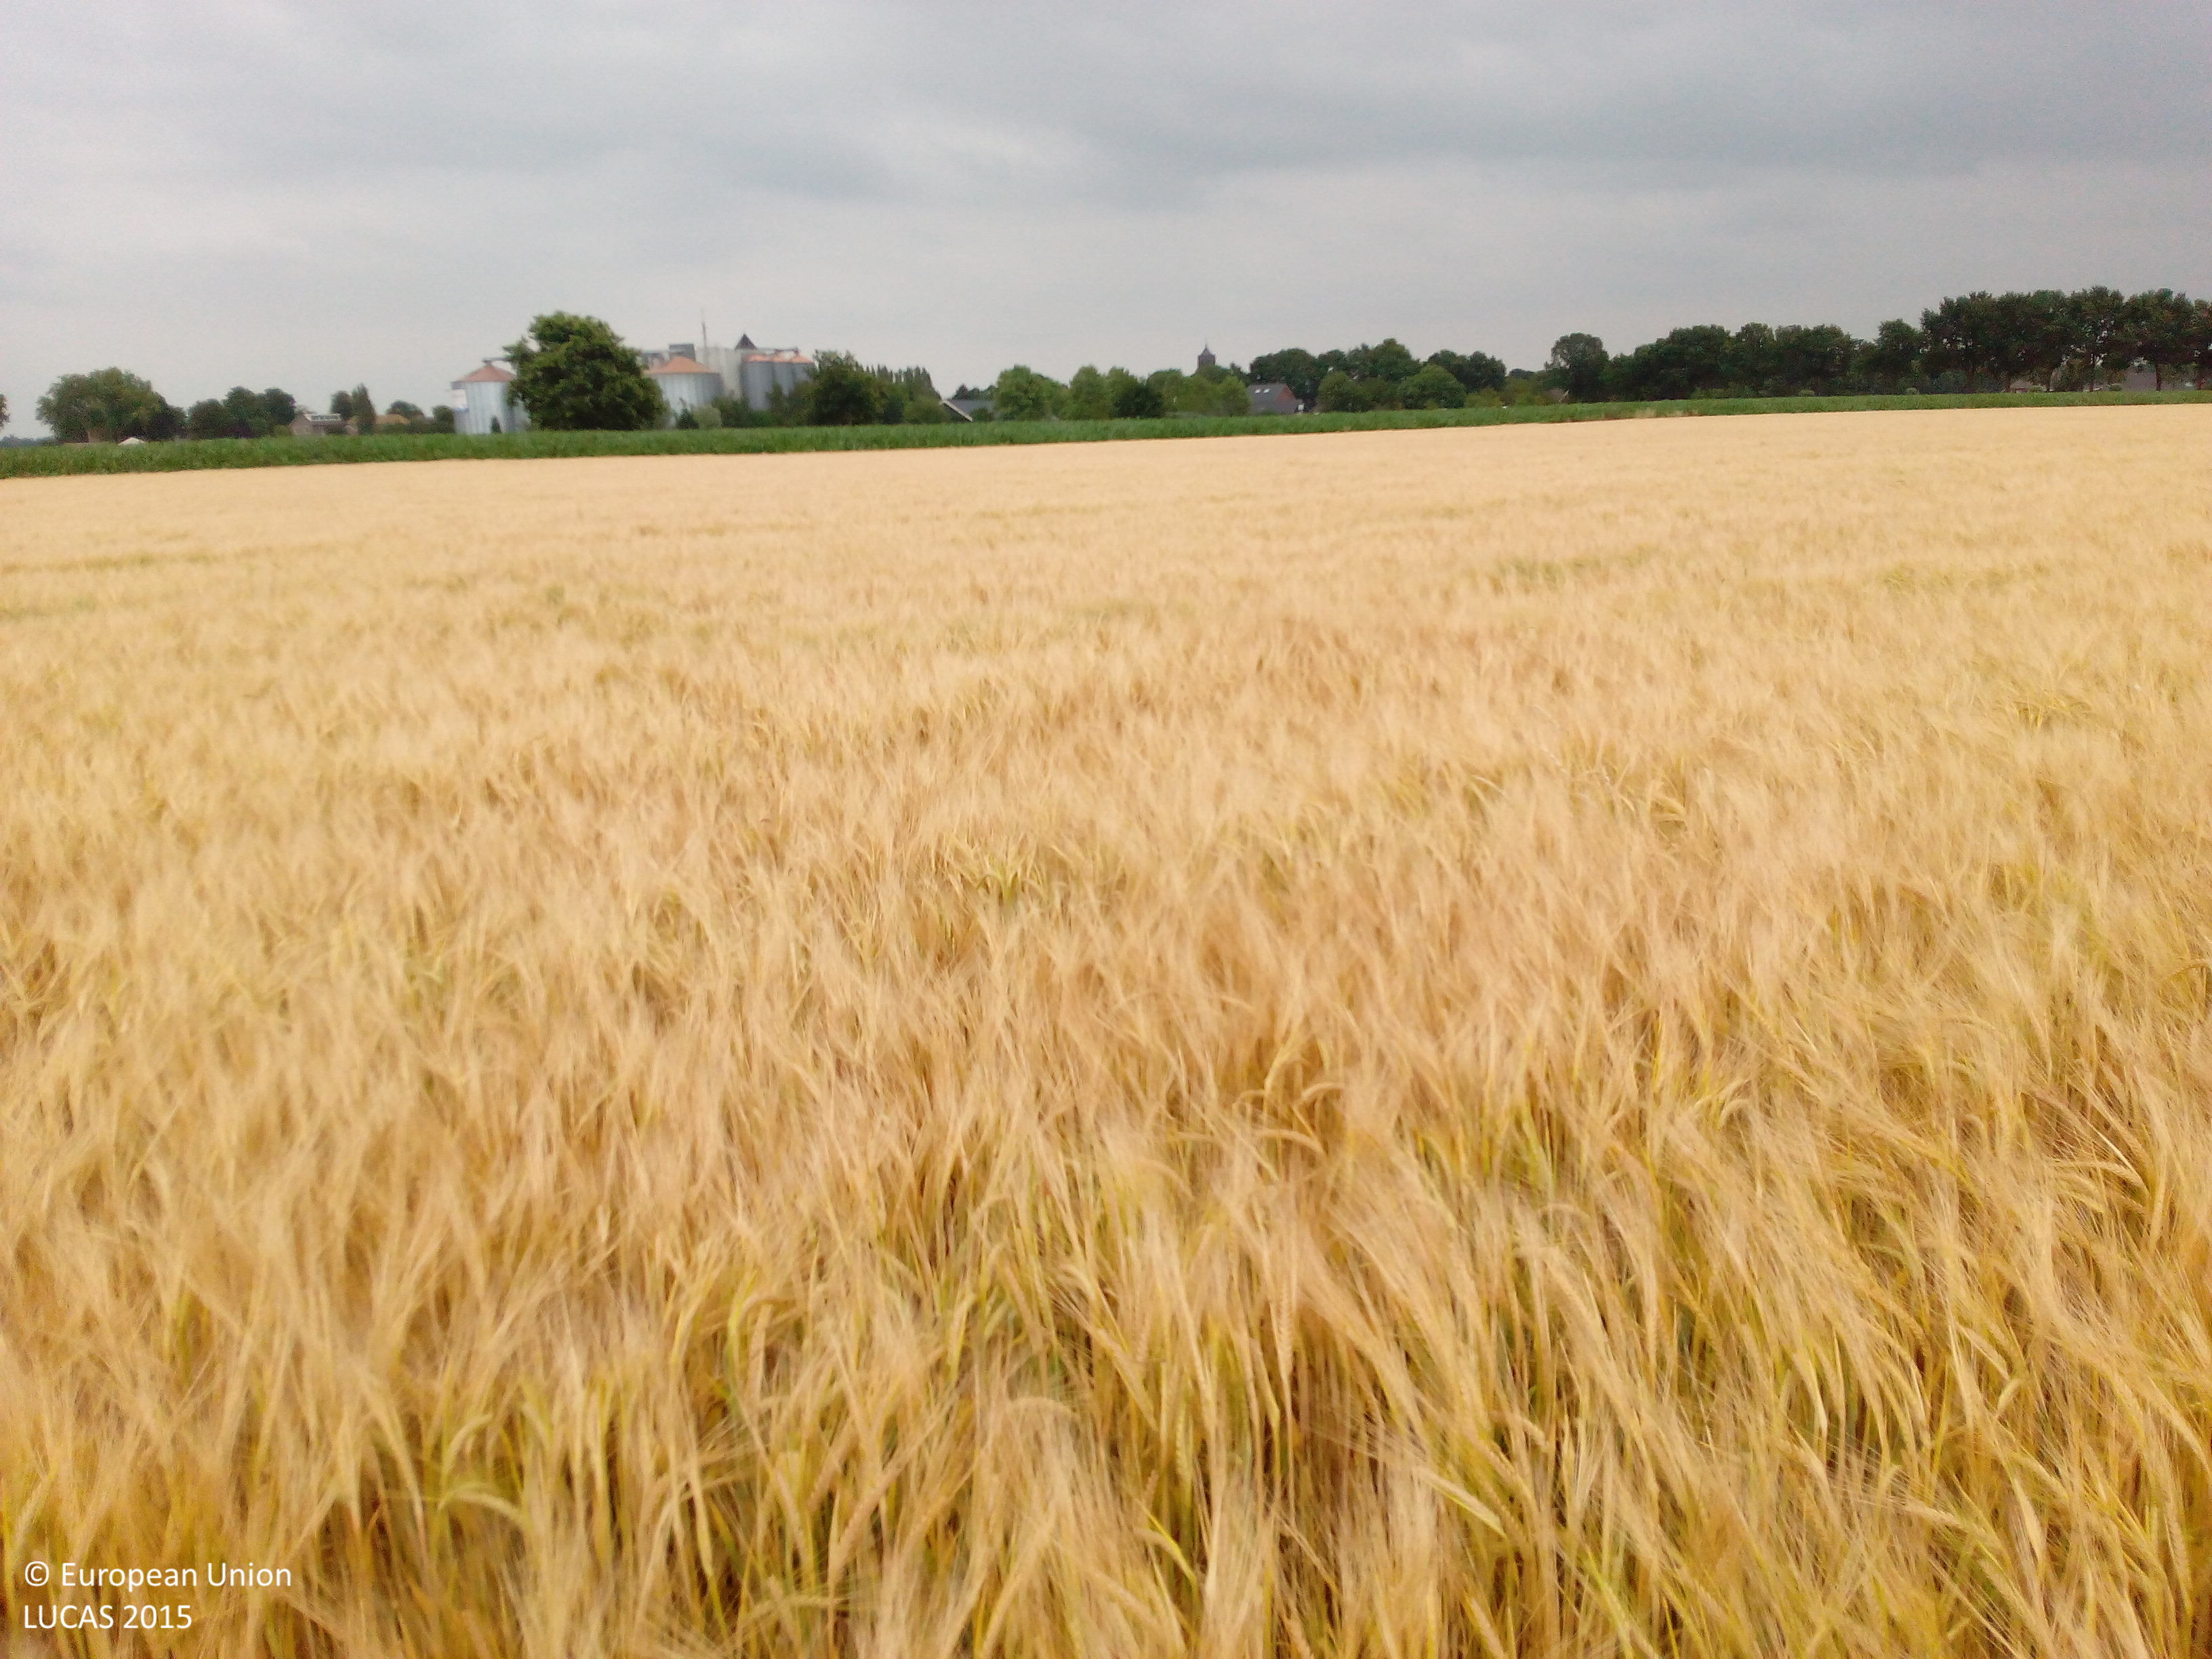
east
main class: Cropland
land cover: Barley
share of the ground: > 75 %
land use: Agriculture (excluding fallow land and kitchen gardens)
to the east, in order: Barley; Maize; Ditches and canals; Single bushes/trees; Maize; Ditches and canals; Fences; Tracks; Inland marshes; Inland fresh water bodies; Grassland without tree/shrub cover
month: July
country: NL
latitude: 51.8878
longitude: 6.2944
